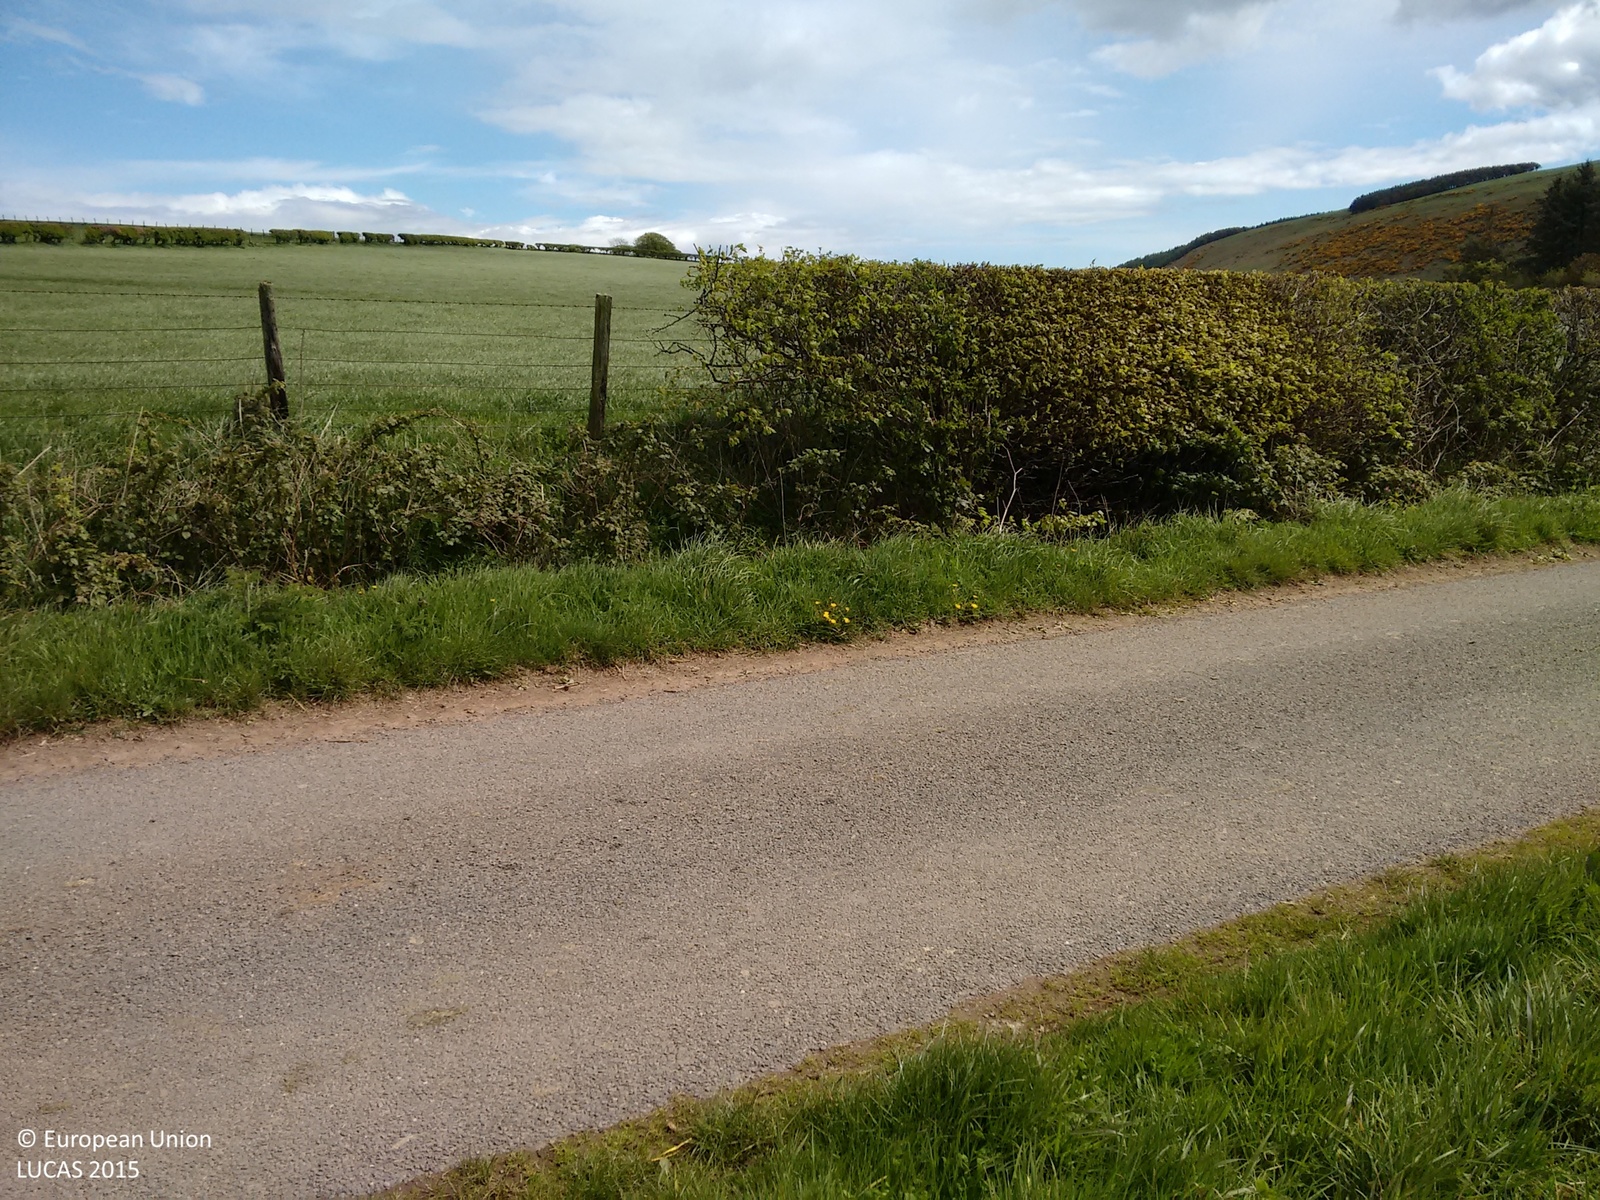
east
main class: Grassland
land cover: Grassland without tree/shrub cover
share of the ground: > 75 %
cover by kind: herbaceous plants 100 %
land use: Agriculture (excluding fallow land and kitchen gardens)
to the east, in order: Grassland without tree/shrub cover; Electric lines; Spontaneously vegetated surfaces; Grassland without tree/shrub cover
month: May
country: GB
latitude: 55.9120
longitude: -2.3925
